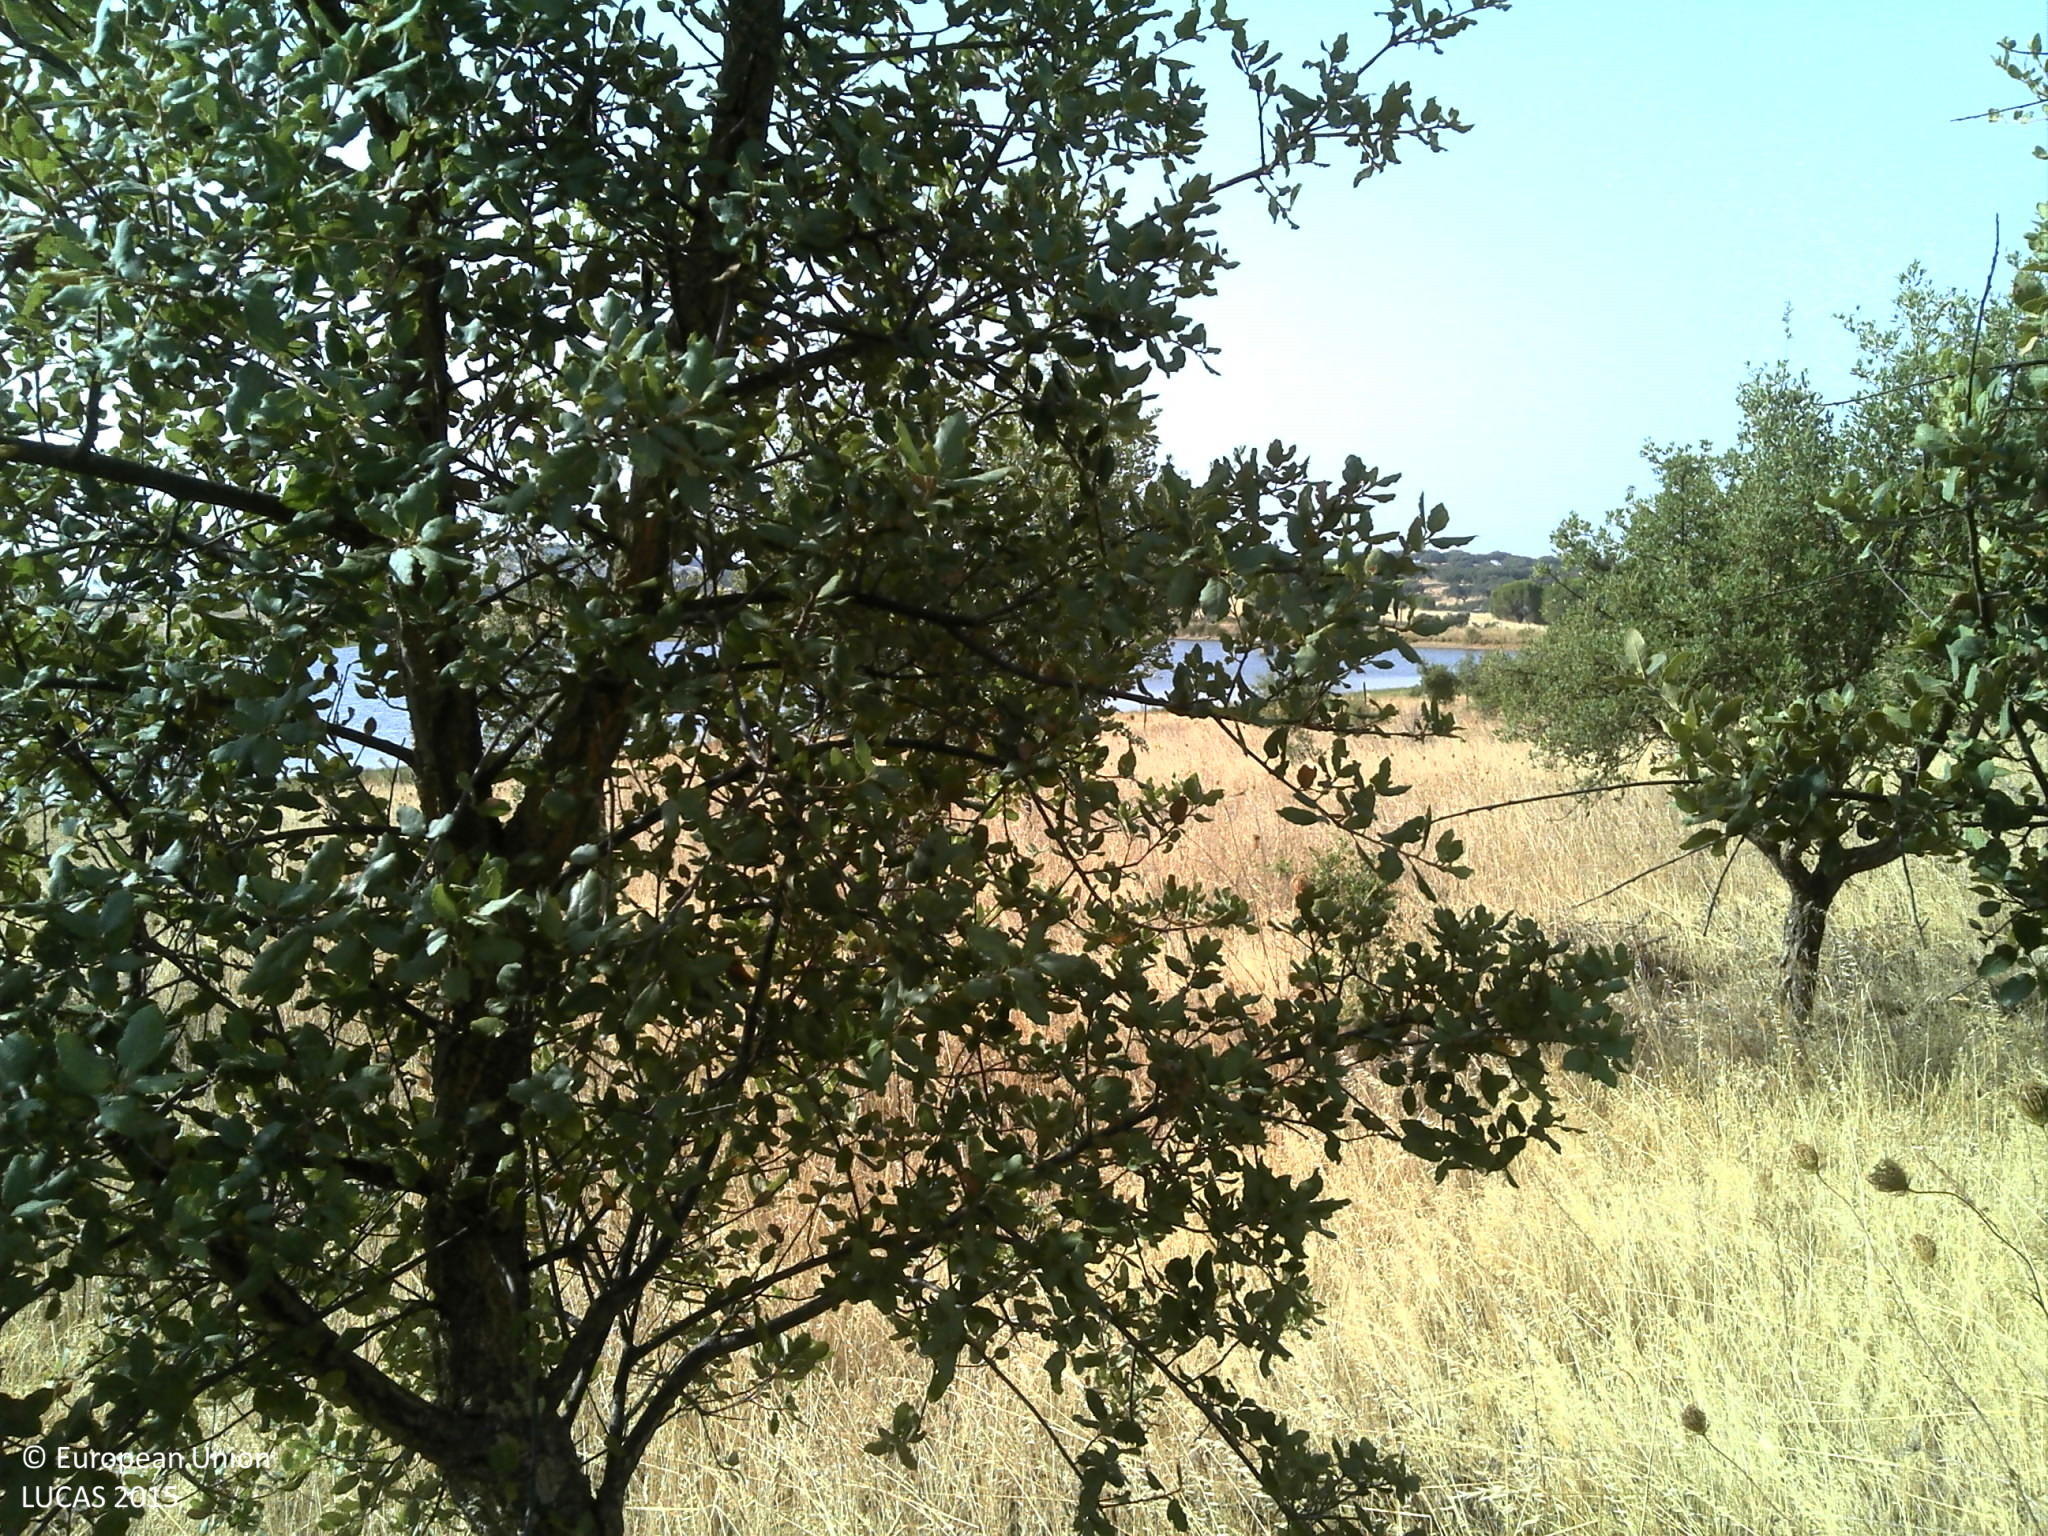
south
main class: Woodland
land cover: Broadleaved woodland
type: broadleaved evergreen forest
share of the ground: 10 - 25 %
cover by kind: herbaceous plants 60 %, unconsolidated bare surface 25 %, broadleaved forest trees 15 %
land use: Forestry
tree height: < 5 m
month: July
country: PT
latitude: 38.7253
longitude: -7.4578
